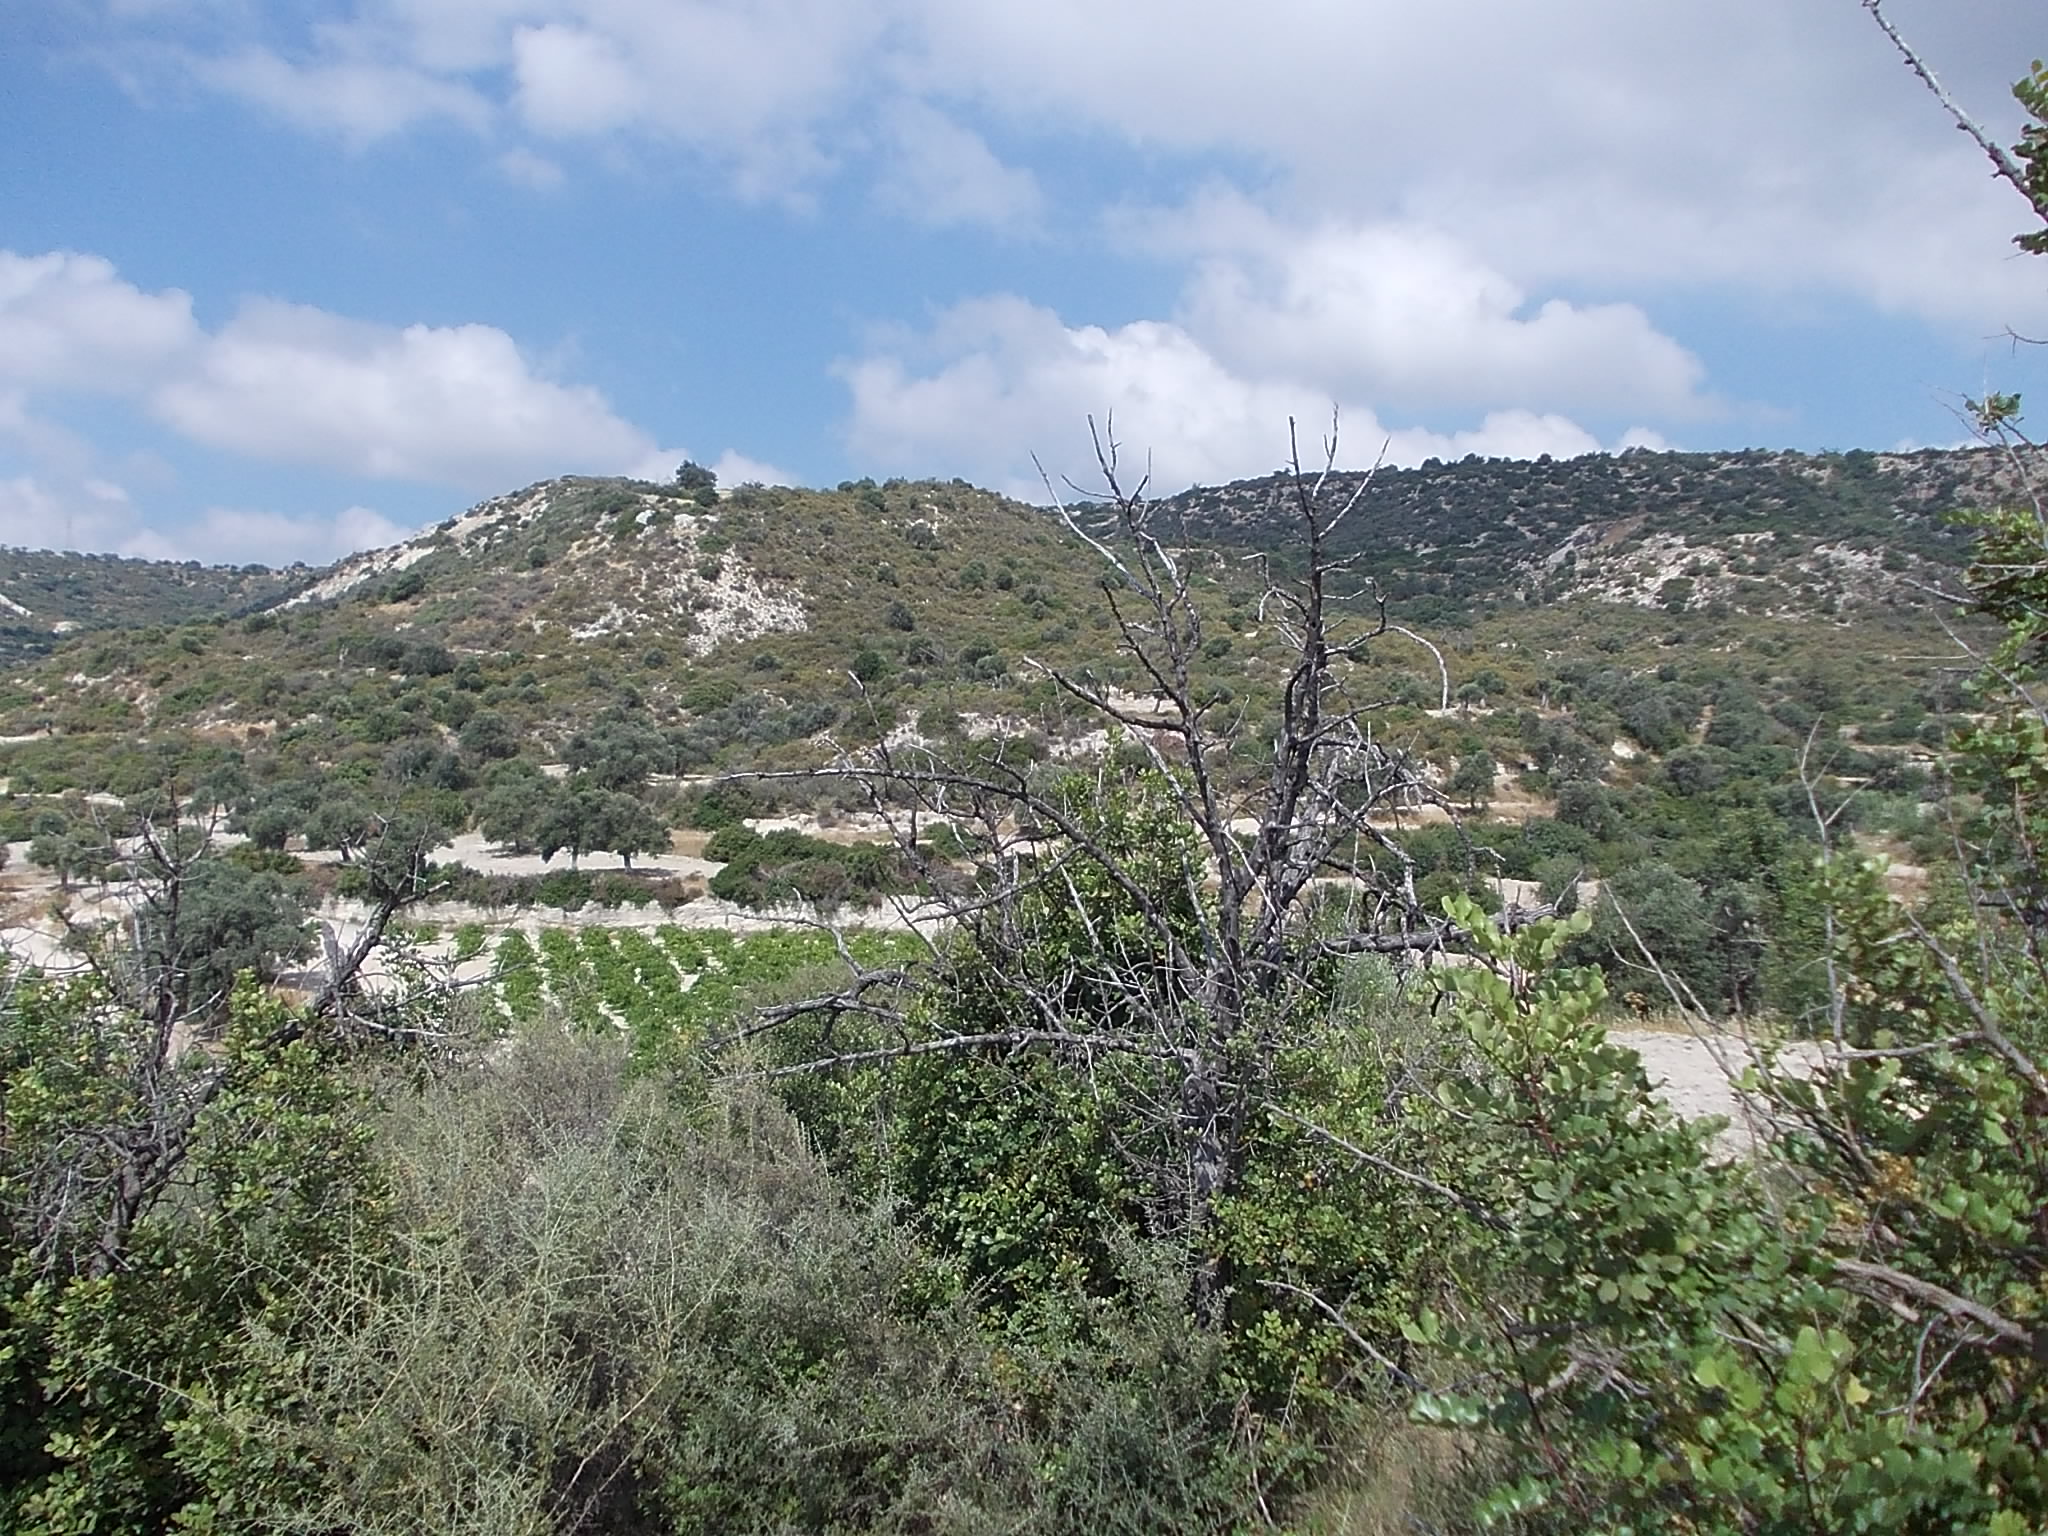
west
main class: Shrubland
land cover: Shrubland without tree cover
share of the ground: 25 - 50 %
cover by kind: shrubs 40 %, herbaceous plants 30 %, unconsolidated bare surface 30 %
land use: Semi-natural and natural areas not in use
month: June
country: CY
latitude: 34.7144
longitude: 32.7232
